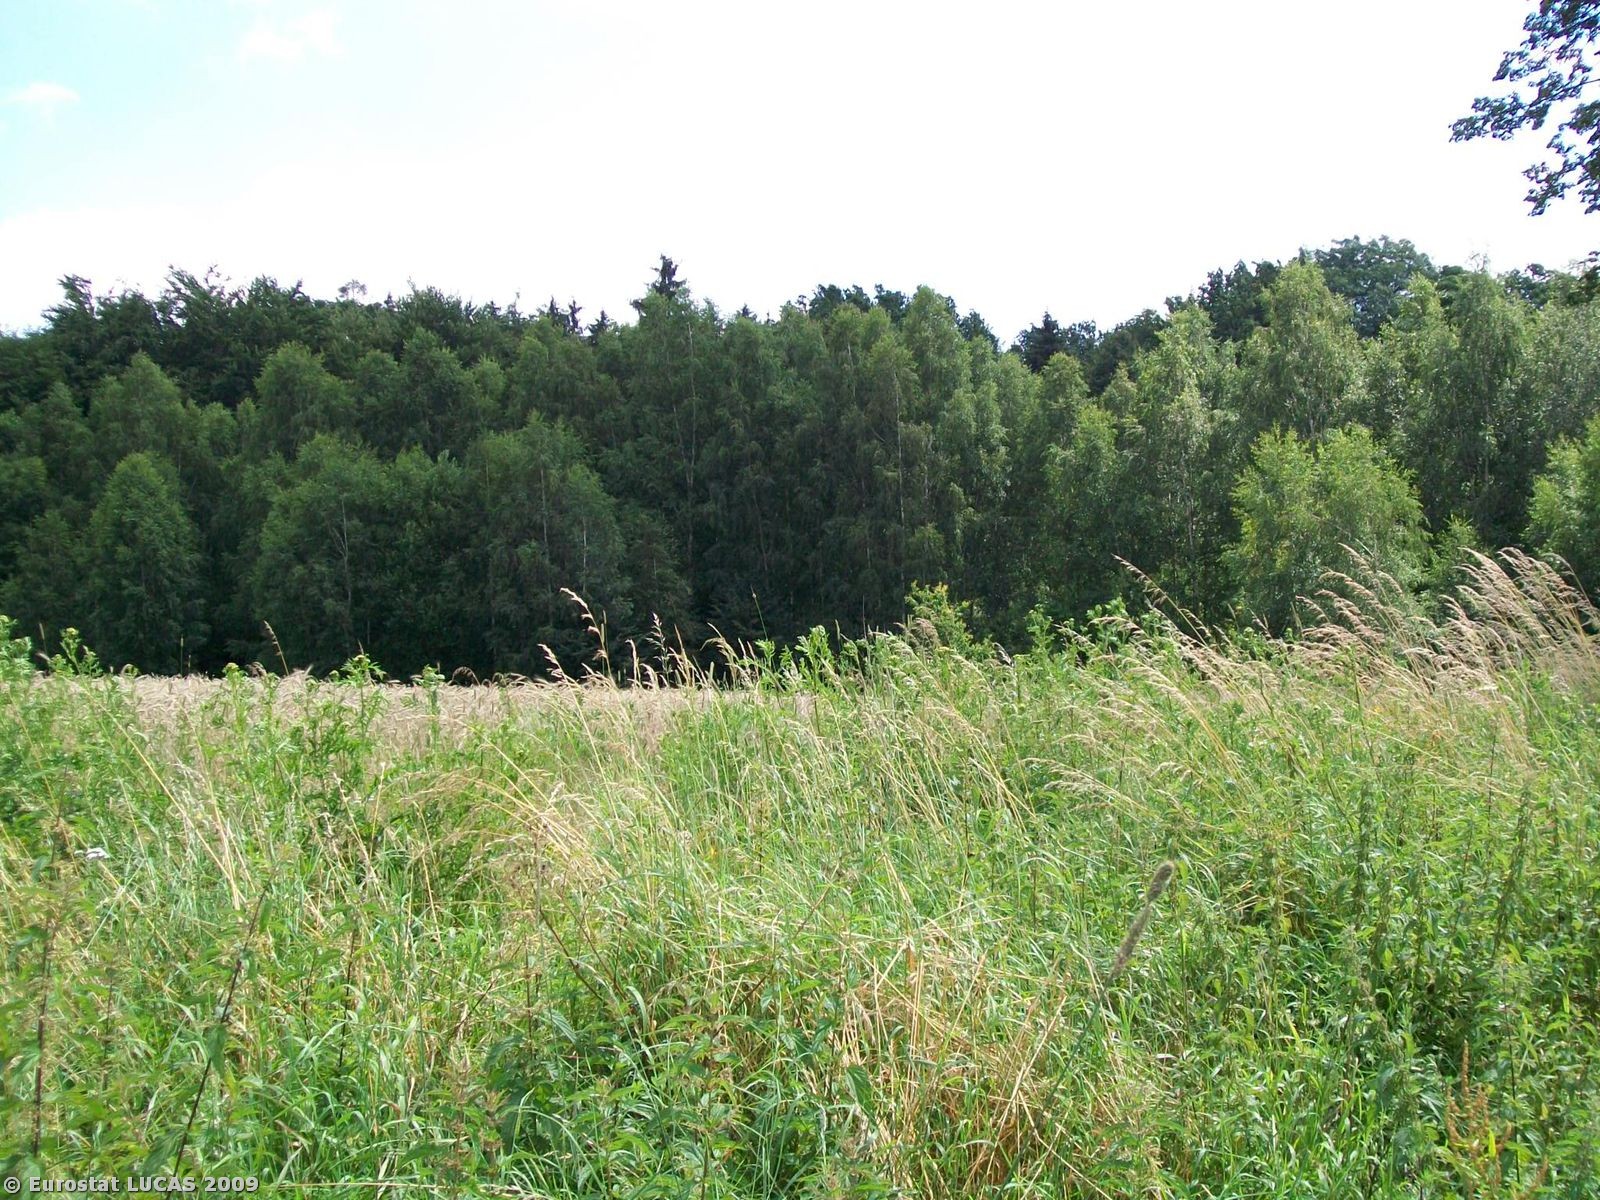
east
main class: Cropland
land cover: Rye
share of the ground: > 75 %
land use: Agriculture (excluding fallow land and kitchen gardens)
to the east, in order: Rye; Grass margins; Tracks; Spontaneously vegetated surfaces; Rye; Mixed woodland; Tracks; Mixed woodland
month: July
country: PL
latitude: 51.0945
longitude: 15.1580
